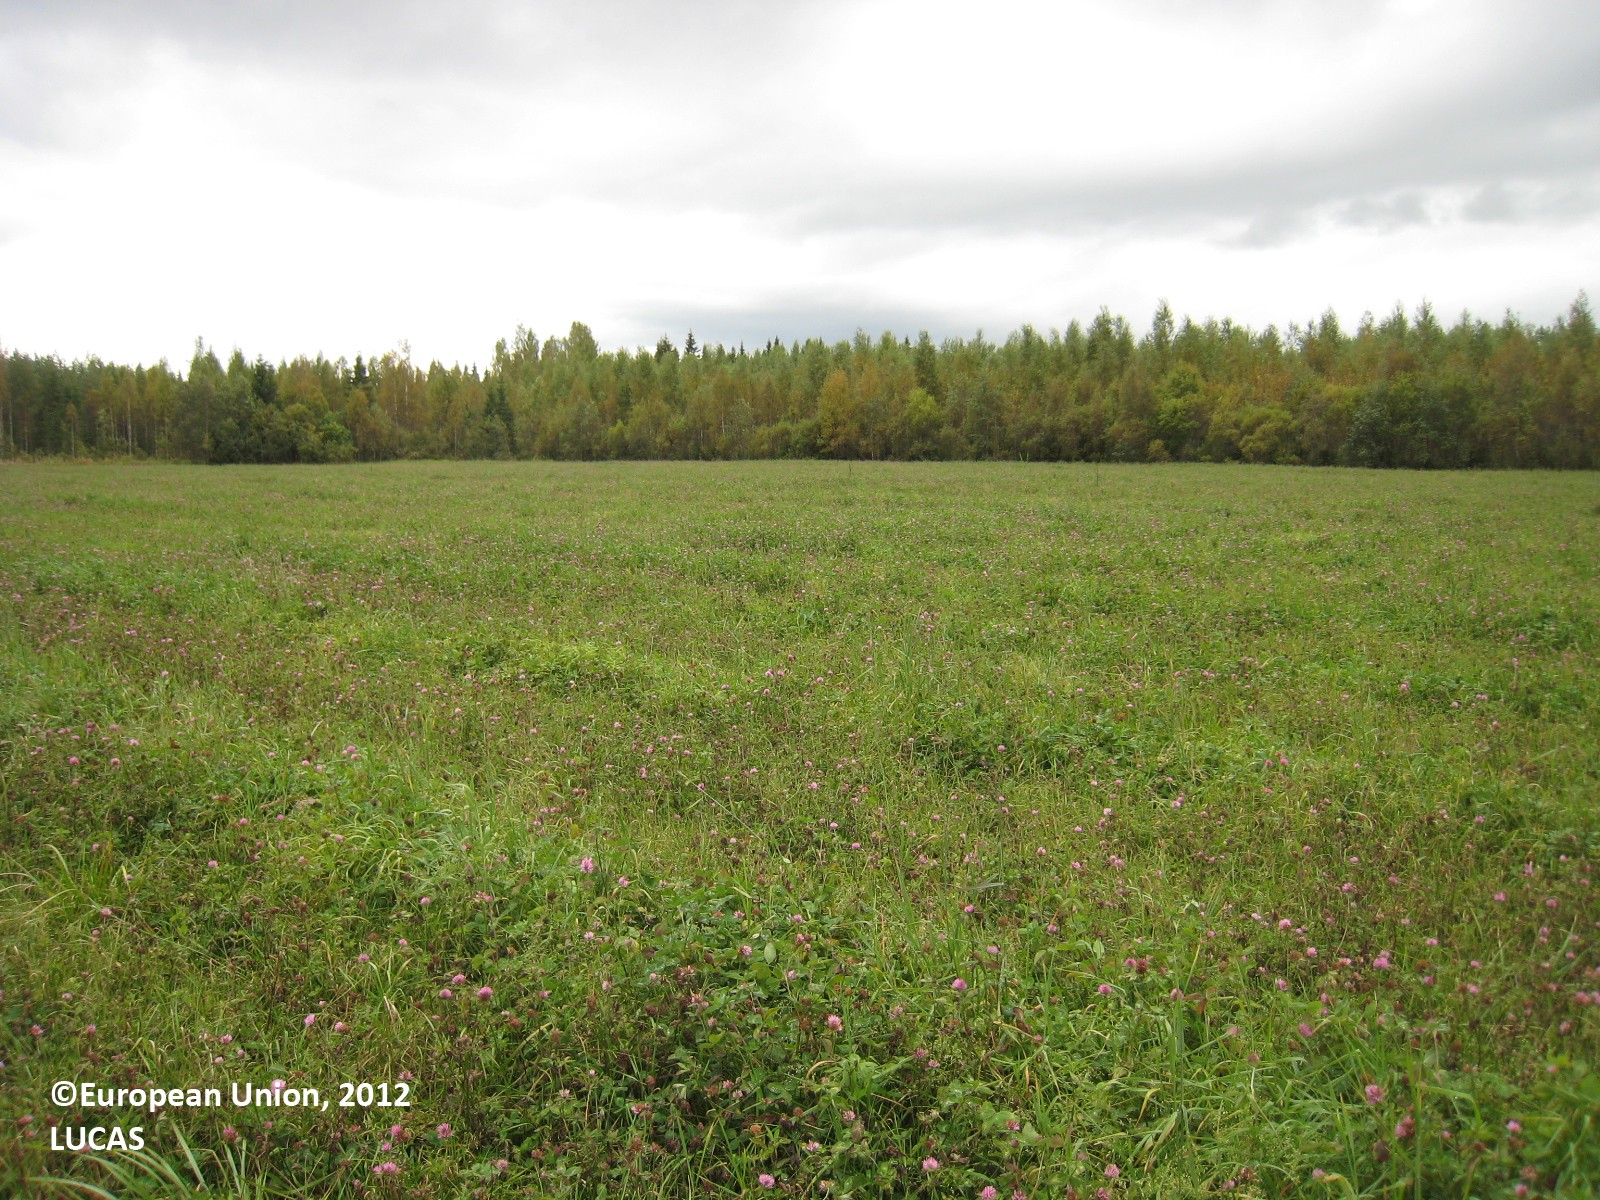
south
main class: Cropland
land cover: Clovers
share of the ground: > 75 %
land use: Fallow land
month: September
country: FI
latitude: 63.0750
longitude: 26.3793
